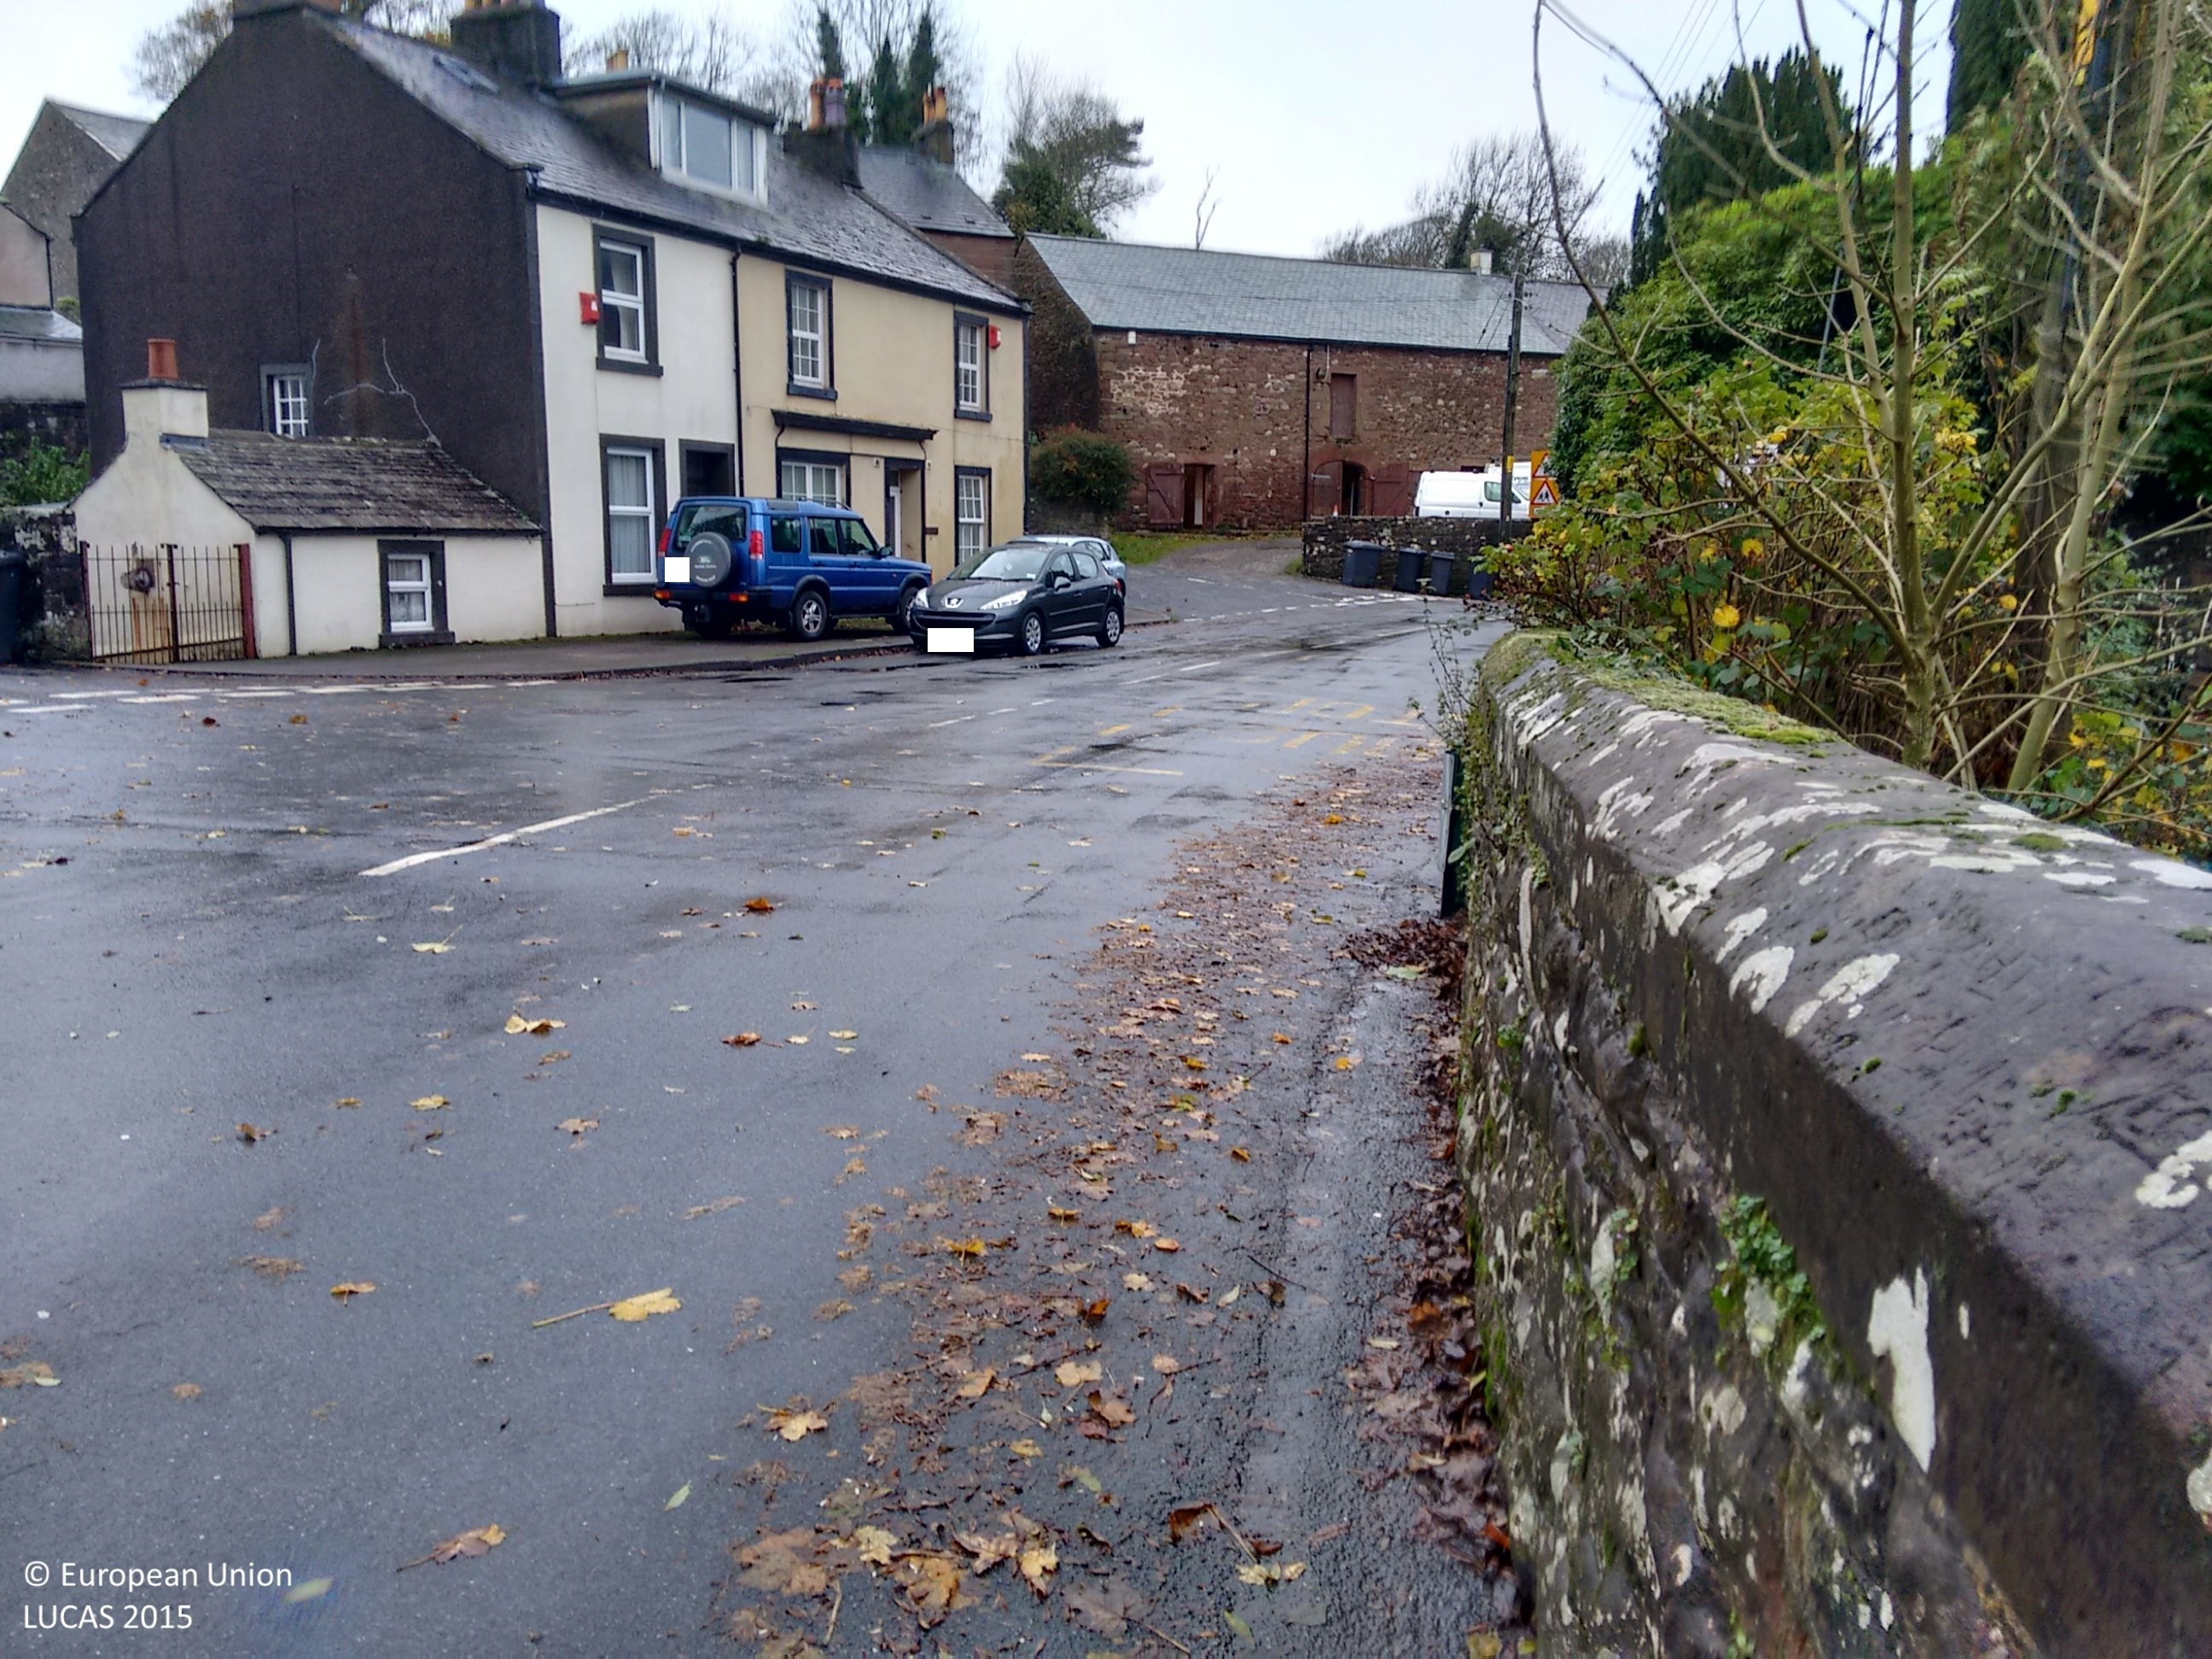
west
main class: Grassland
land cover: Grassland without tree/shrub cover
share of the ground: > 75 %
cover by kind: herbaceous plants 100 %
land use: Residential
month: November
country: GB
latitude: 54.4461
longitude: -3.5141
